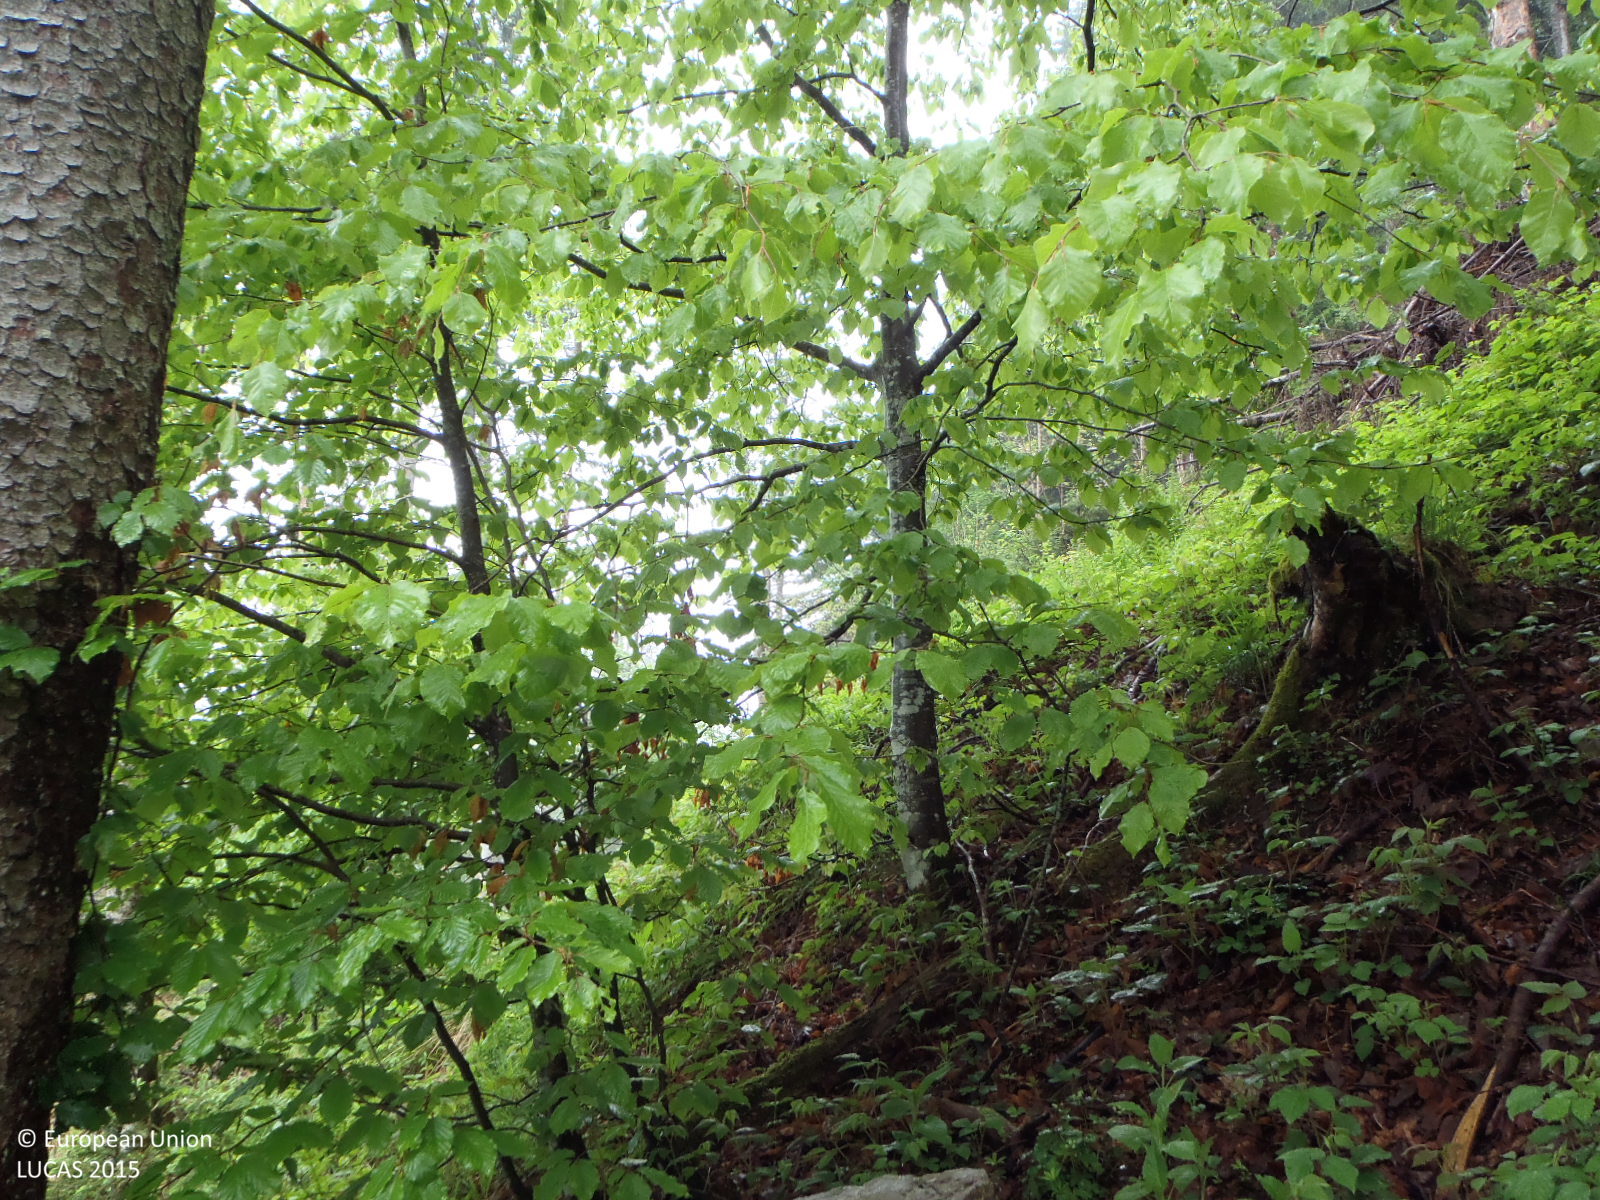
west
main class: Woodland
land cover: Spruce dominated mixed woodland
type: alpine coniferous forest
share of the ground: > 75 %
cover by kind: coniferous forest trees 60 %, broadleaved forest trees 20 %, herbaceous plants 15 %, lichens and mosses 5 %
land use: Forestry
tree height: > 5 m
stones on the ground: < 10 %
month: May
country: AT
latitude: 47.6342
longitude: 12.6203
